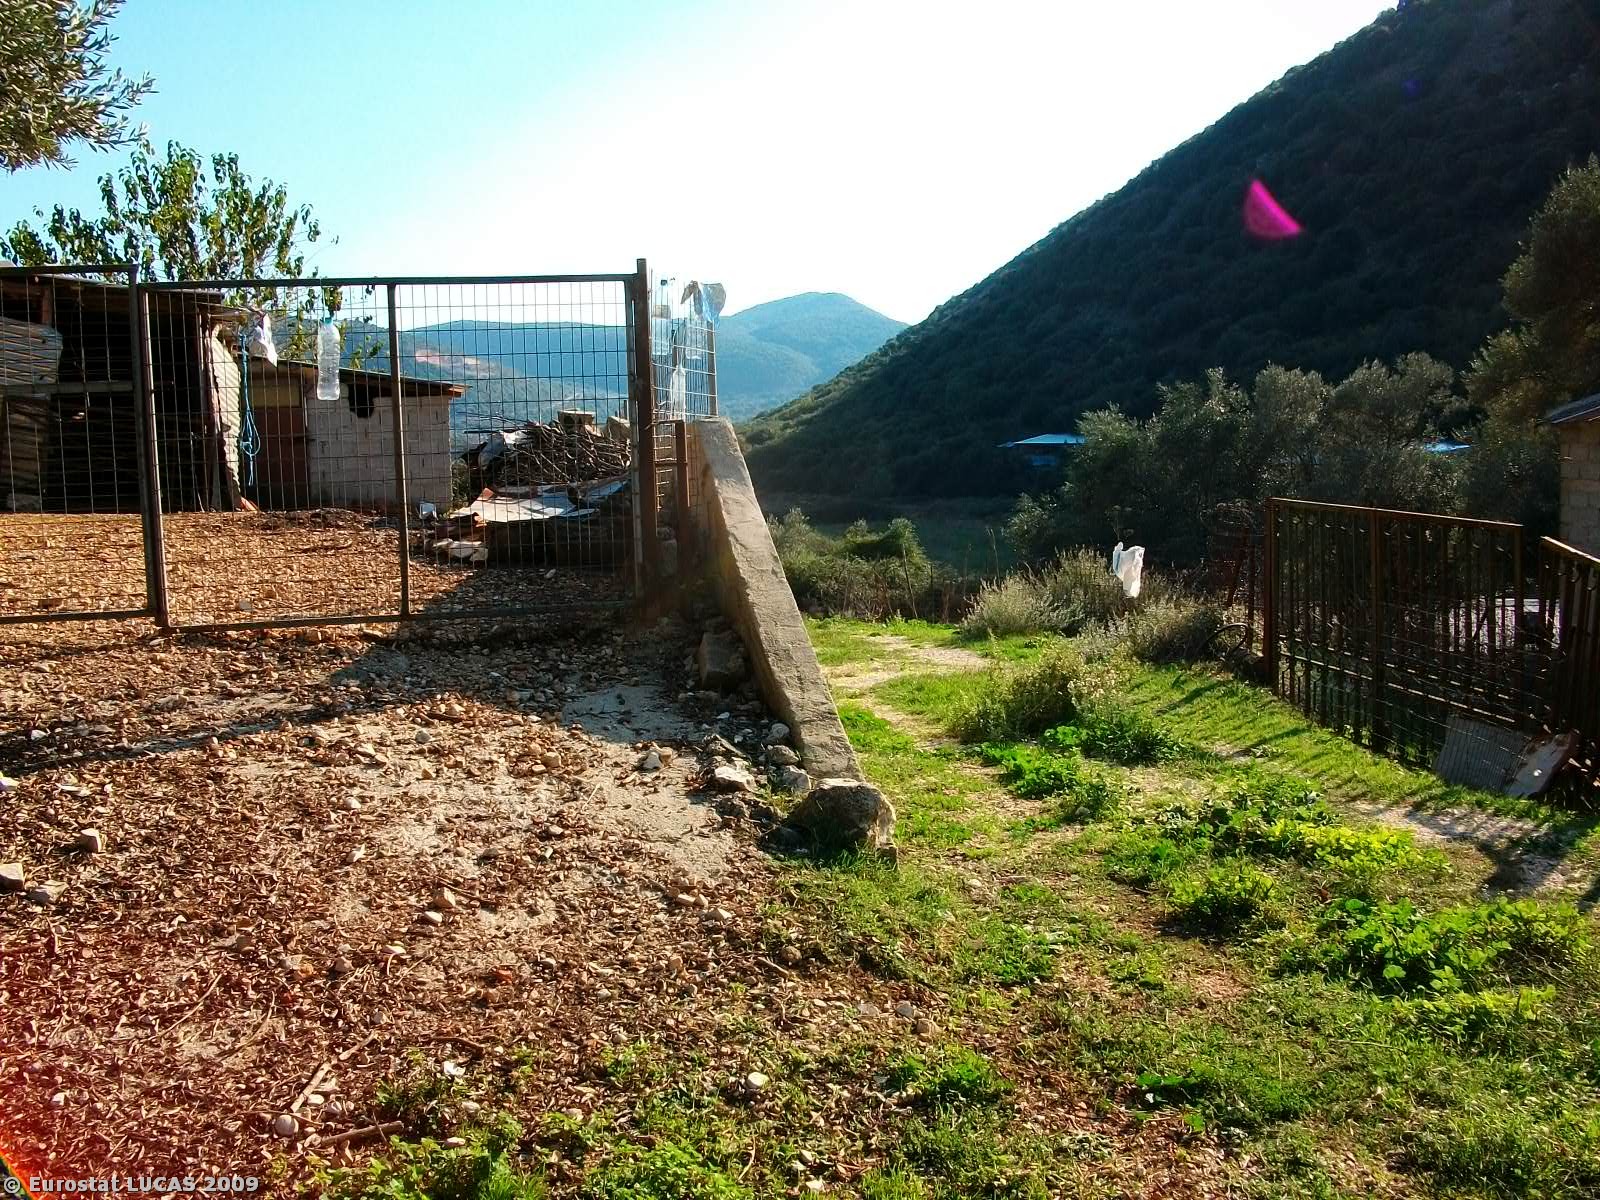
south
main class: Cropland
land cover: Nuts trees
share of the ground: 25 - 50 %
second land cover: Bare land
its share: > 75 %
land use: Kitchen garden
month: October
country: GR
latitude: 39.3942
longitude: 20.4820
